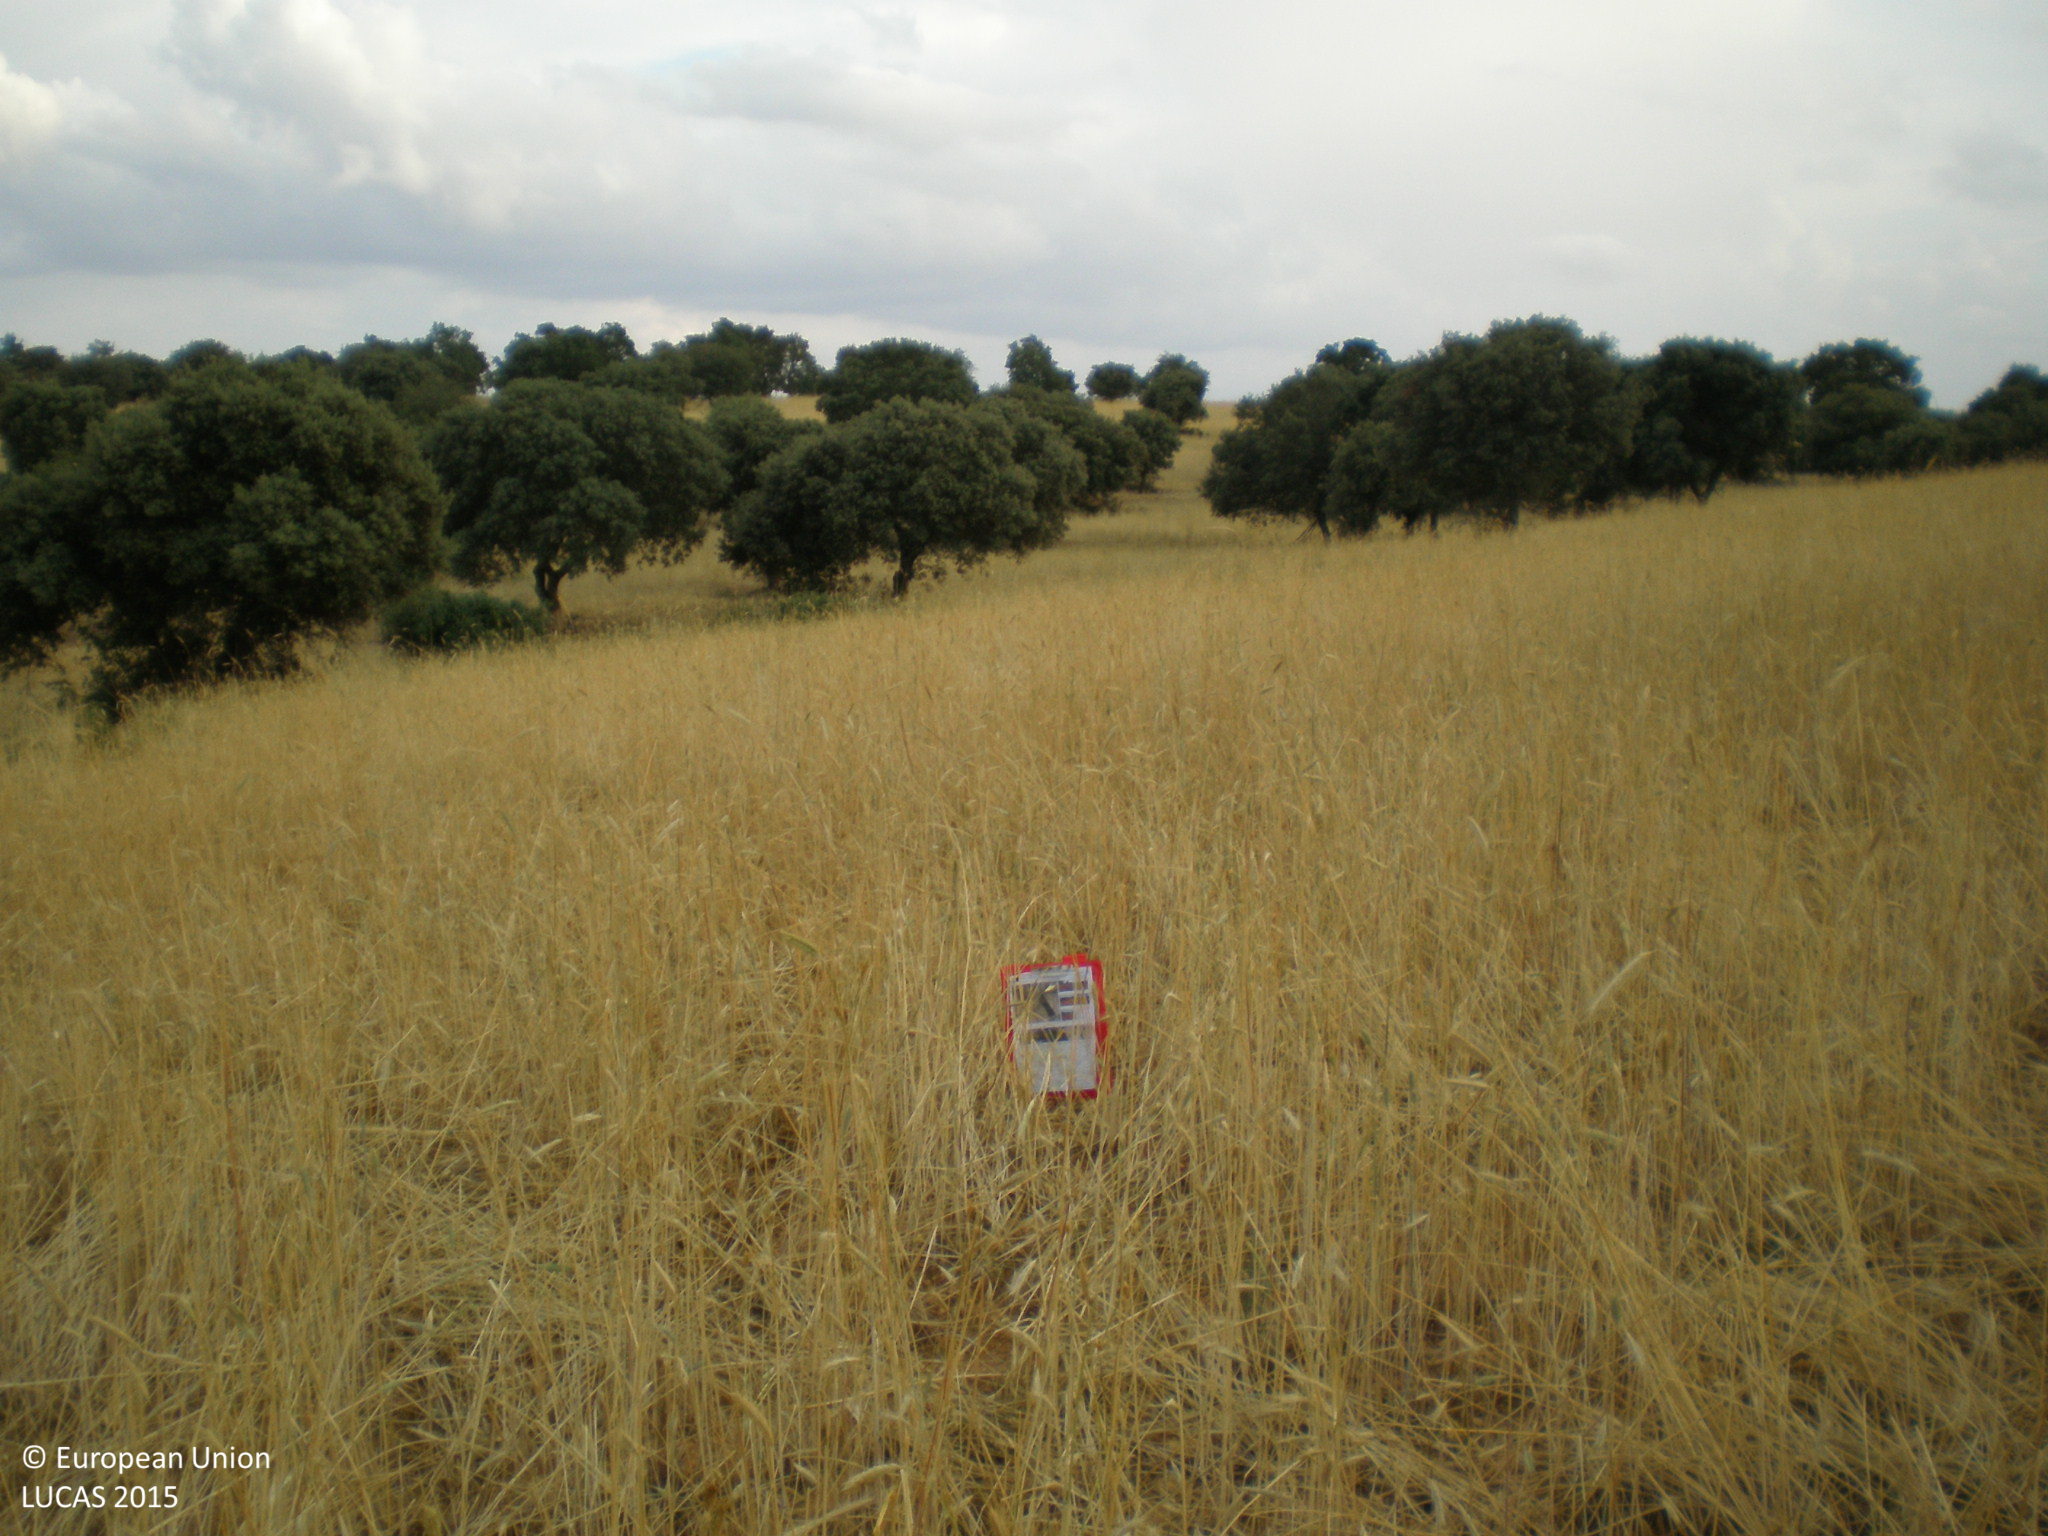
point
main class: Cropland
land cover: Rye
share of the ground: > 75 %
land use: Agriculture (excluding fallow land and kitchen gardens)
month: June
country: ES
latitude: 41.2221
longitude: -5.7935
